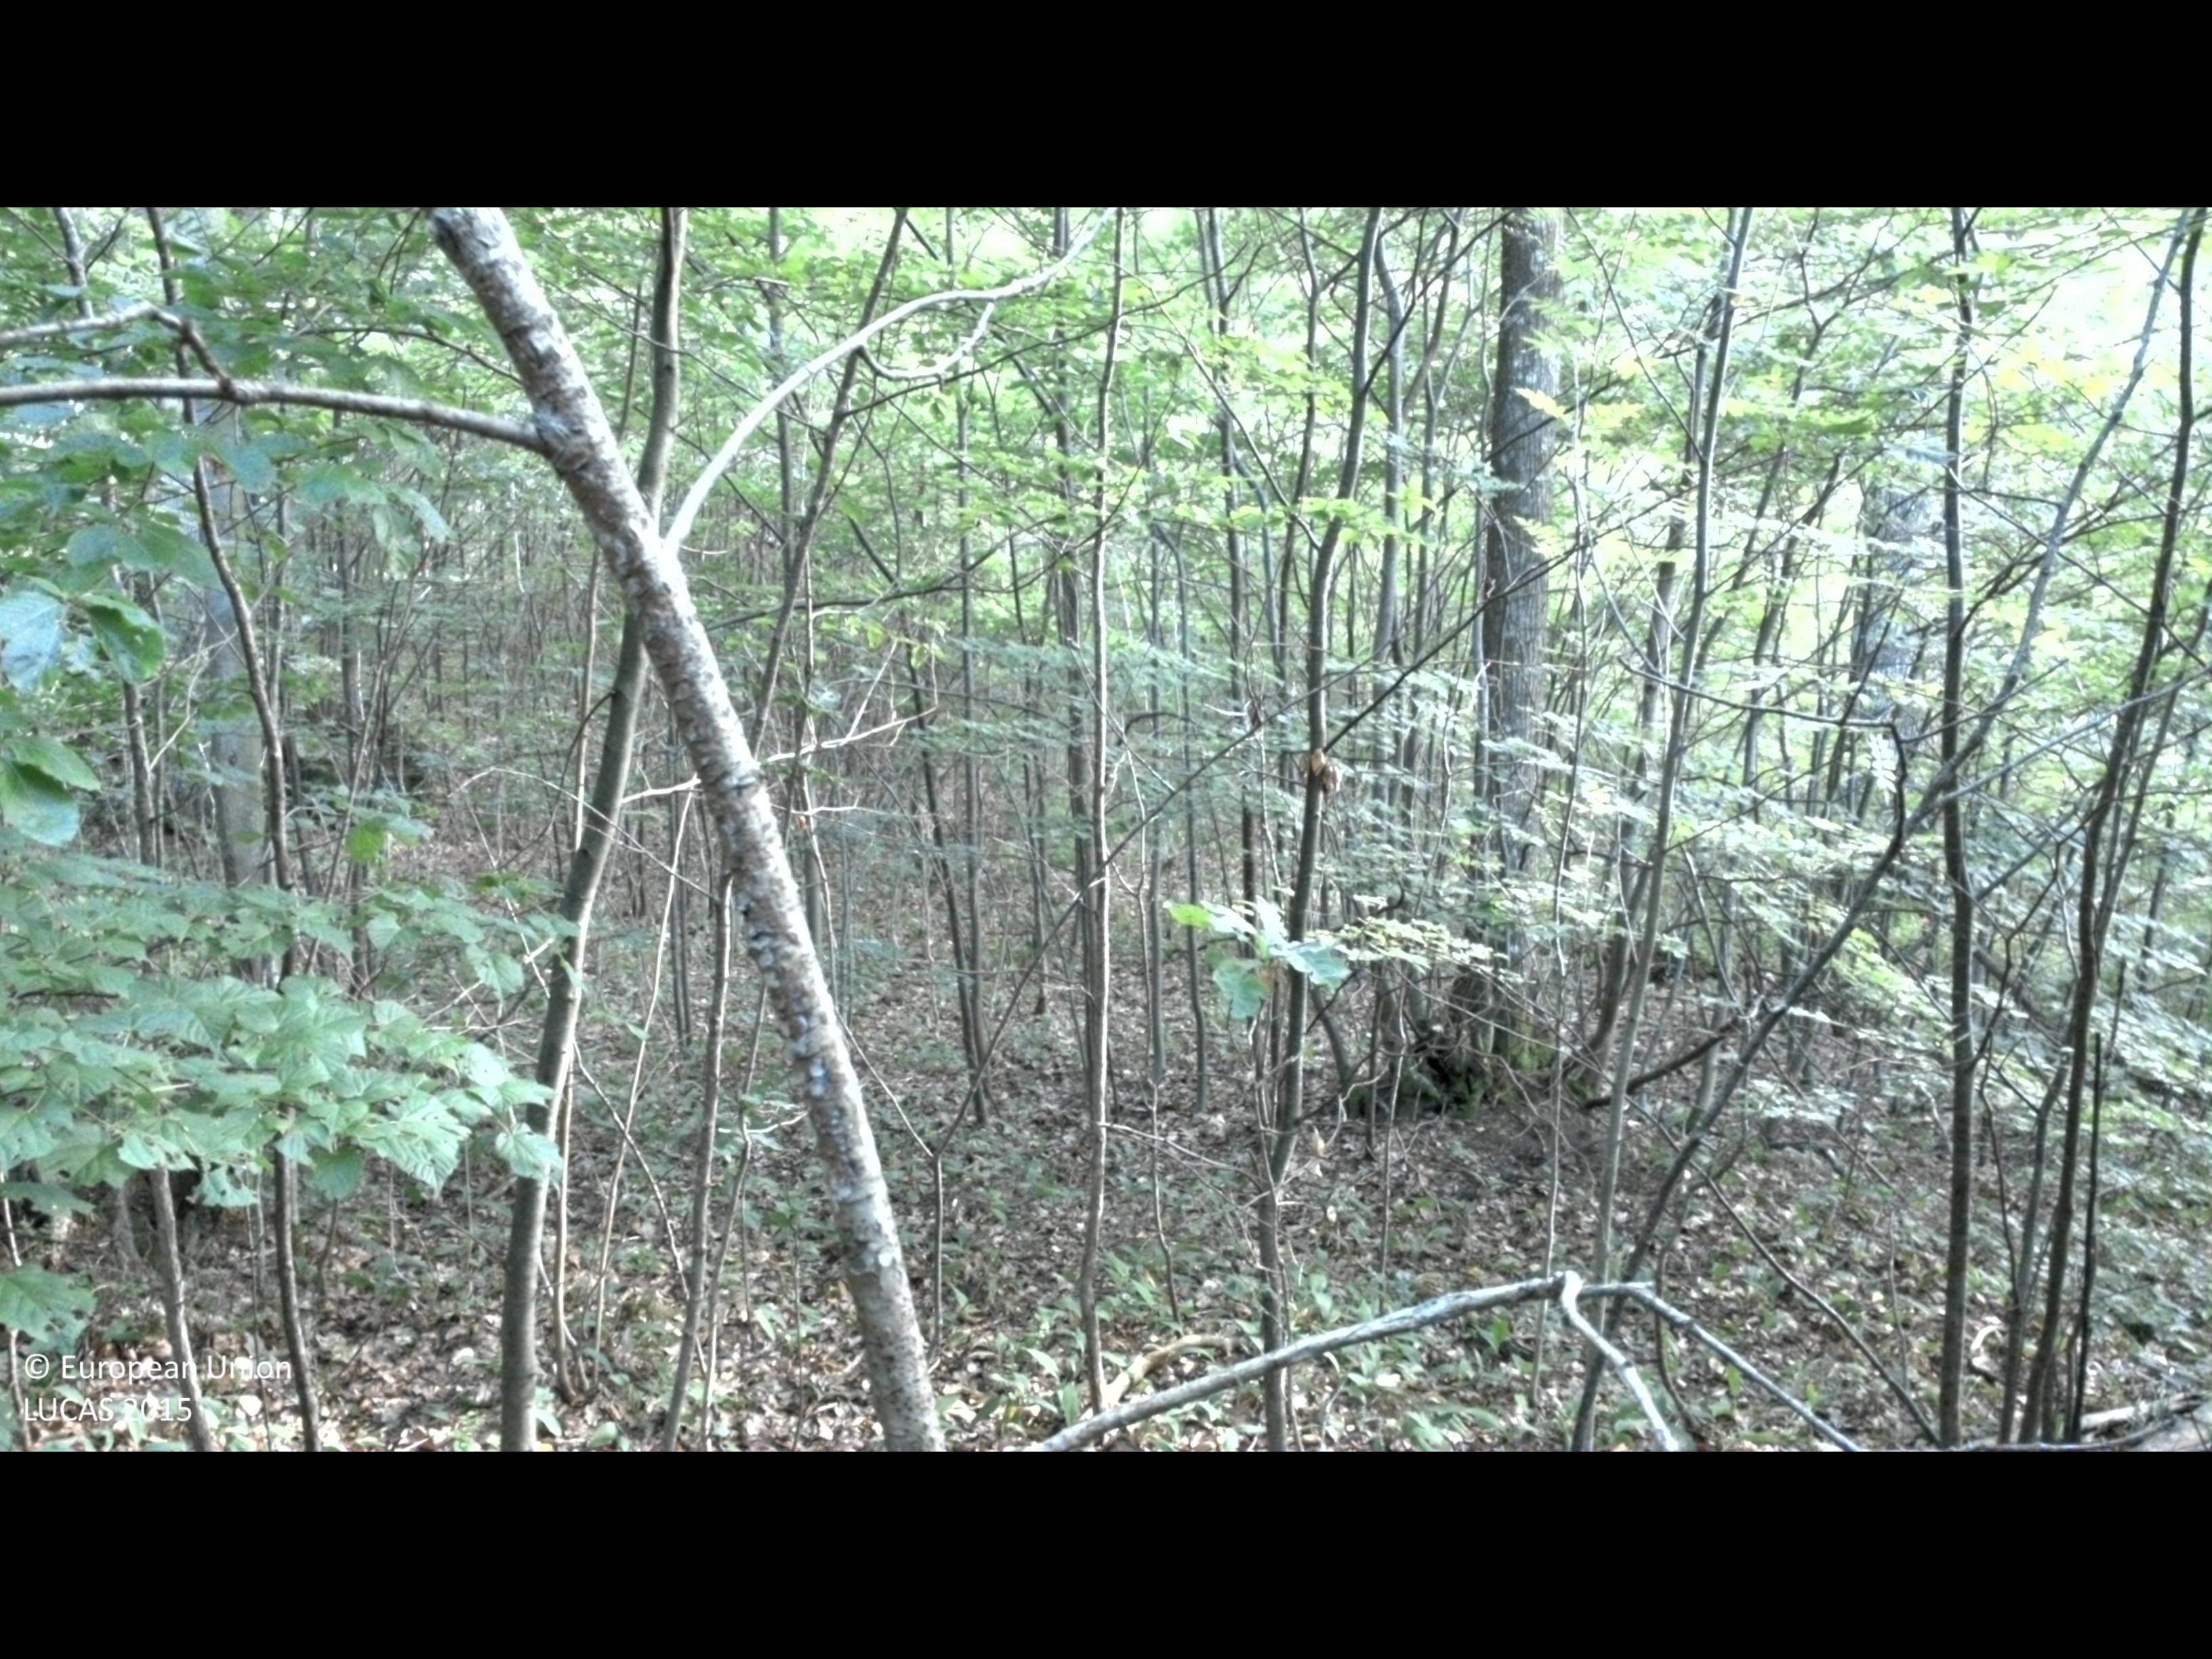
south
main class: Woodland
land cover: Broadleaved woodland
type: hemiboreal forest and nemoral coniferous forest and mixed broadleaved-coniferous forest
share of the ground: > 75 %
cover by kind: broadleaved forest trees 85 %, shrubs 15 %
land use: Amenities, museums, leisure
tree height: > 5 m
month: August
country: SE
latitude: 56.6068
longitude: 14.1513
